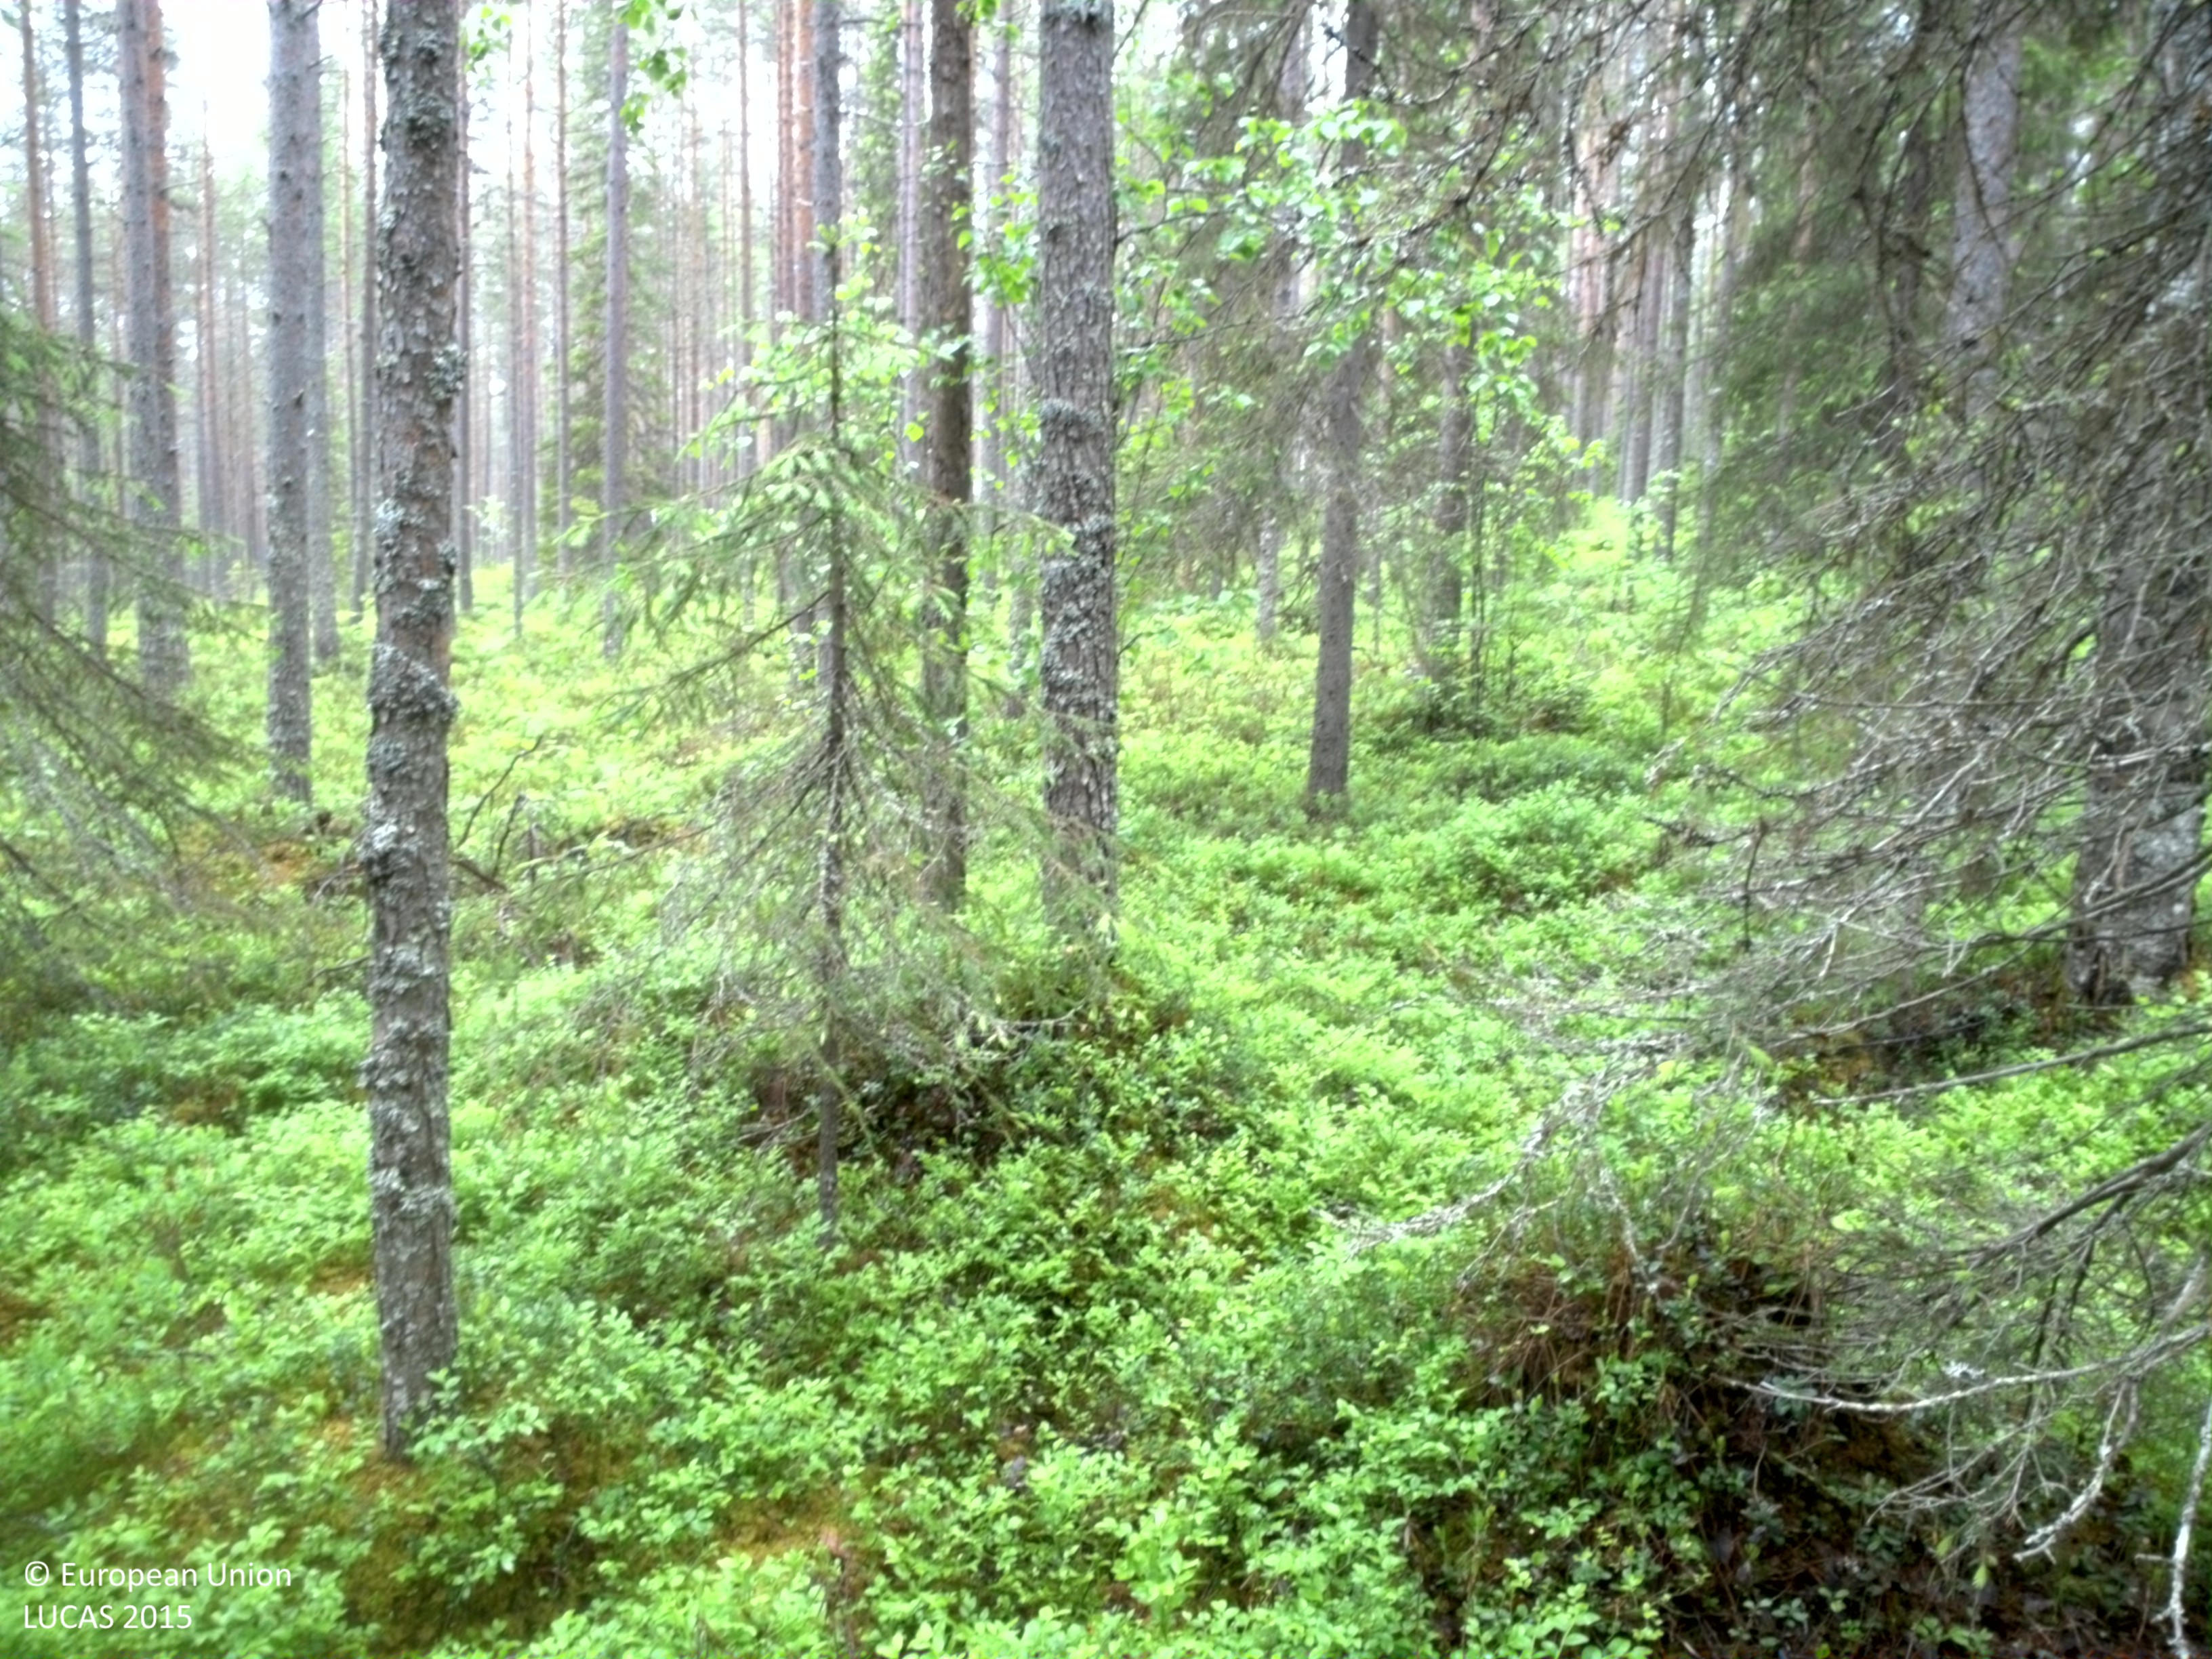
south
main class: Woodland
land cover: Pine dominated coniferous woodland
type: boreal forest
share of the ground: 25 - 50 %
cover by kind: shrubs 55 %, coniferous forest trees 40 %, broadleaved forest trees 5 %
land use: Forestry
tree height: > 5 m
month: June
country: SE
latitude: 66.4326
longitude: 22.7737
